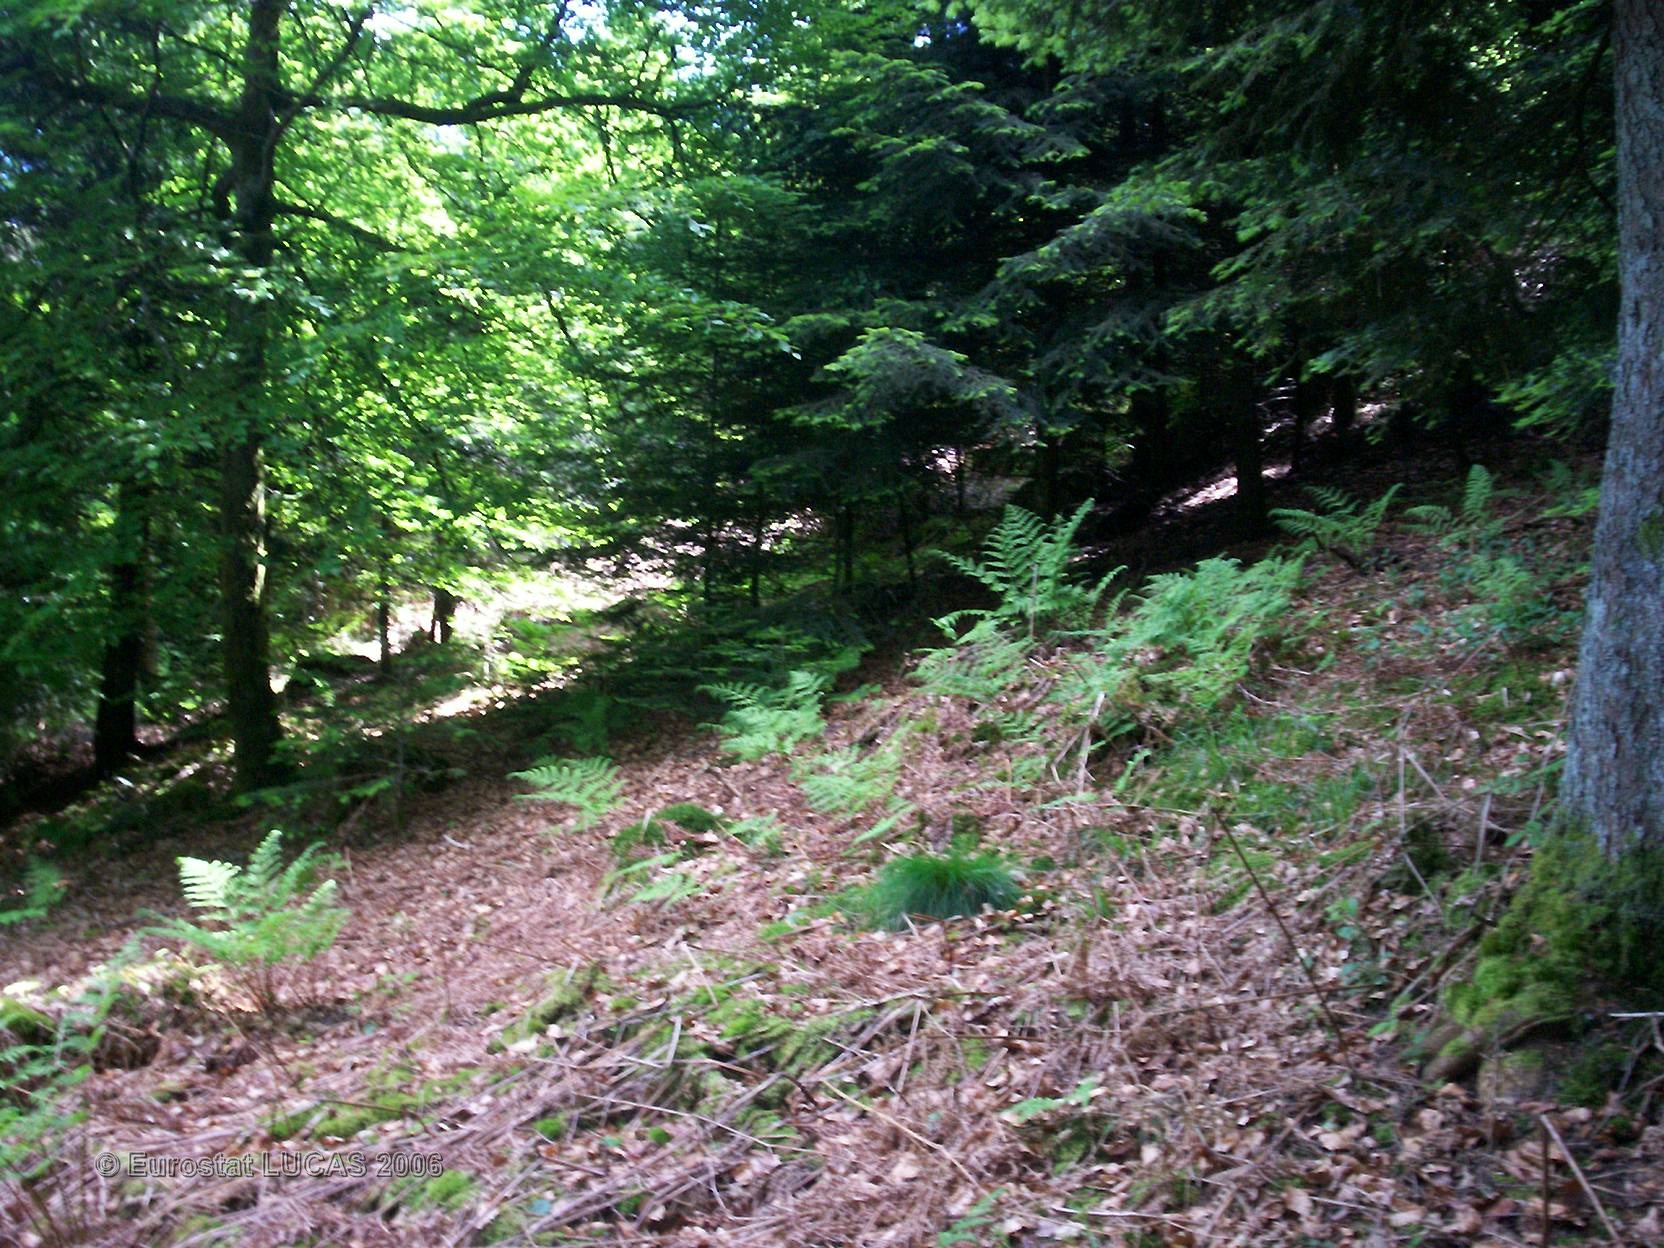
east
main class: Woodland
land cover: Mixed forest
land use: Forestry
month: May
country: FR
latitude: 48.0453
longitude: 6.6072
